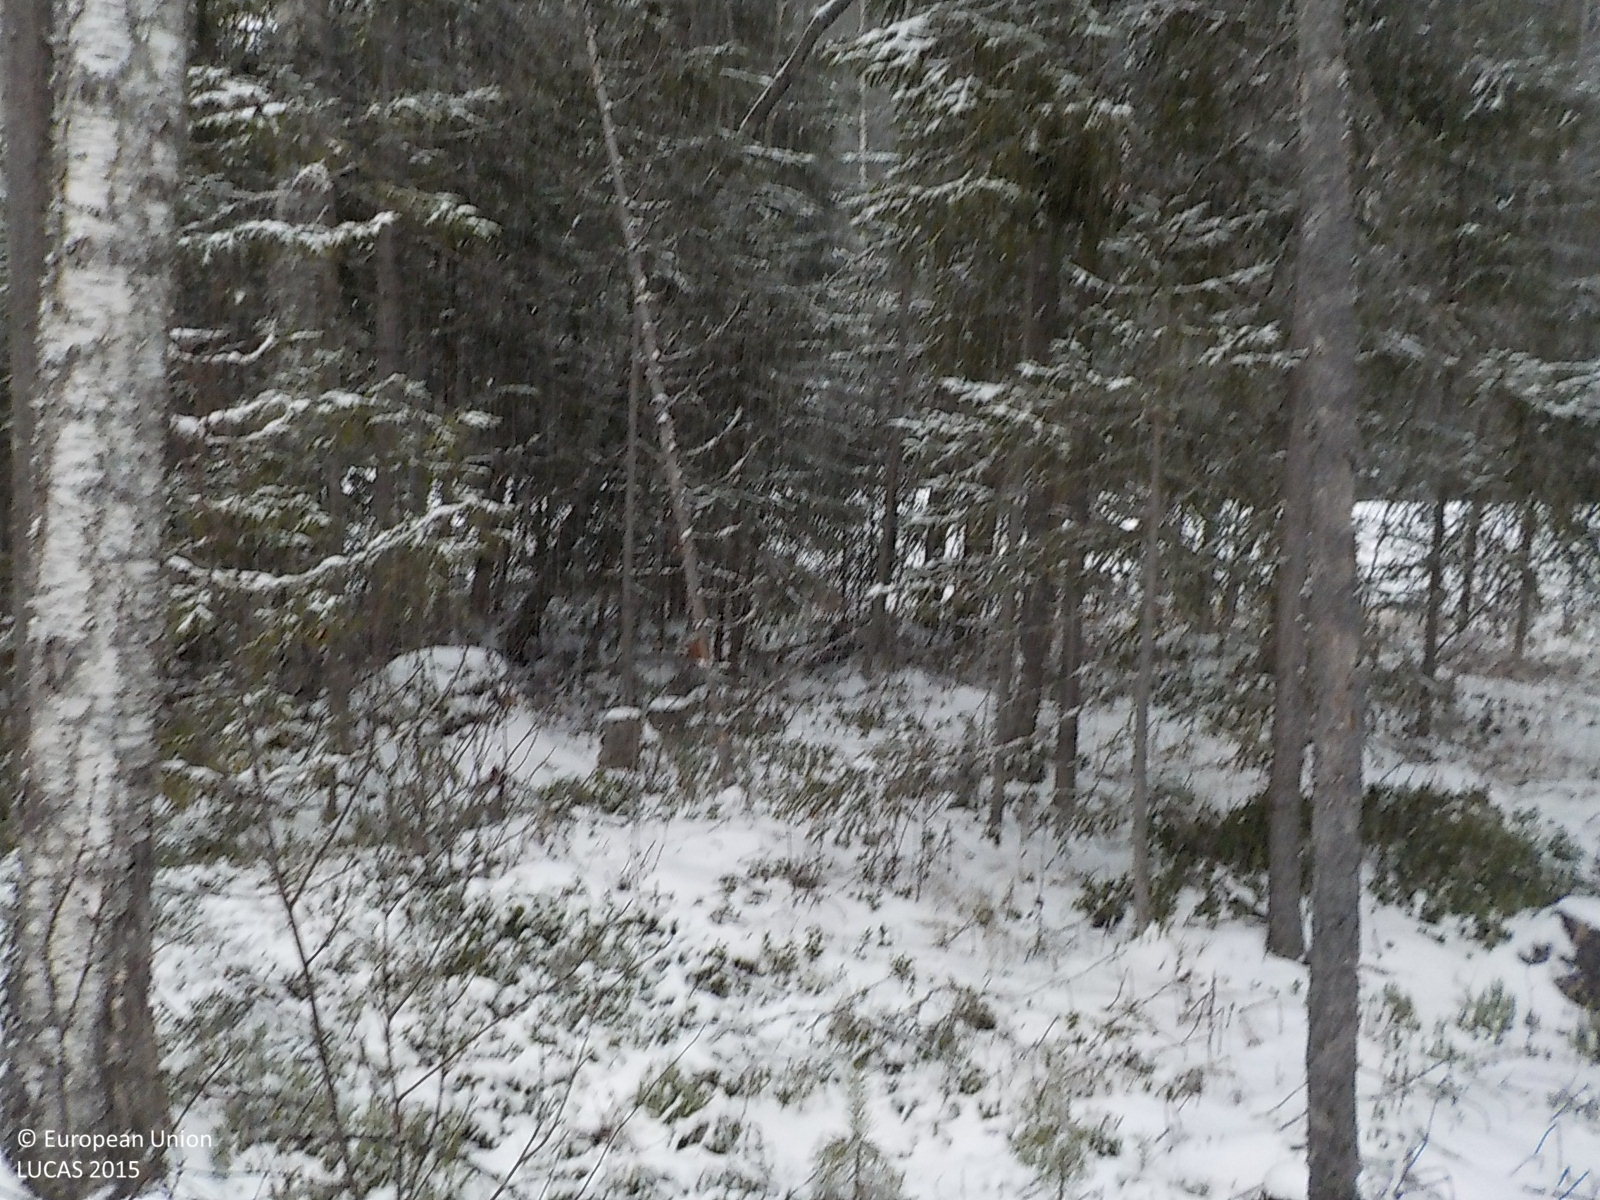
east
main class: Woodland
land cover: Other mixed woodland
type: boreal forest
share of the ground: 50 - 75 %
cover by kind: broadleaved forest trees 40 %, coniferous forest trees 30 %, herbaceous plants 30 %
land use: Forestry
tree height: > 5 m
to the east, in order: Other mixed woodland; Grassland without tree/shrub cover; Paved roads, cycling and walking lanes; Other mixed woodland; Pine dominated coniferous woodland; Other mixed woodland
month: December
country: SE
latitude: 63.3020
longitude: 16.9773
